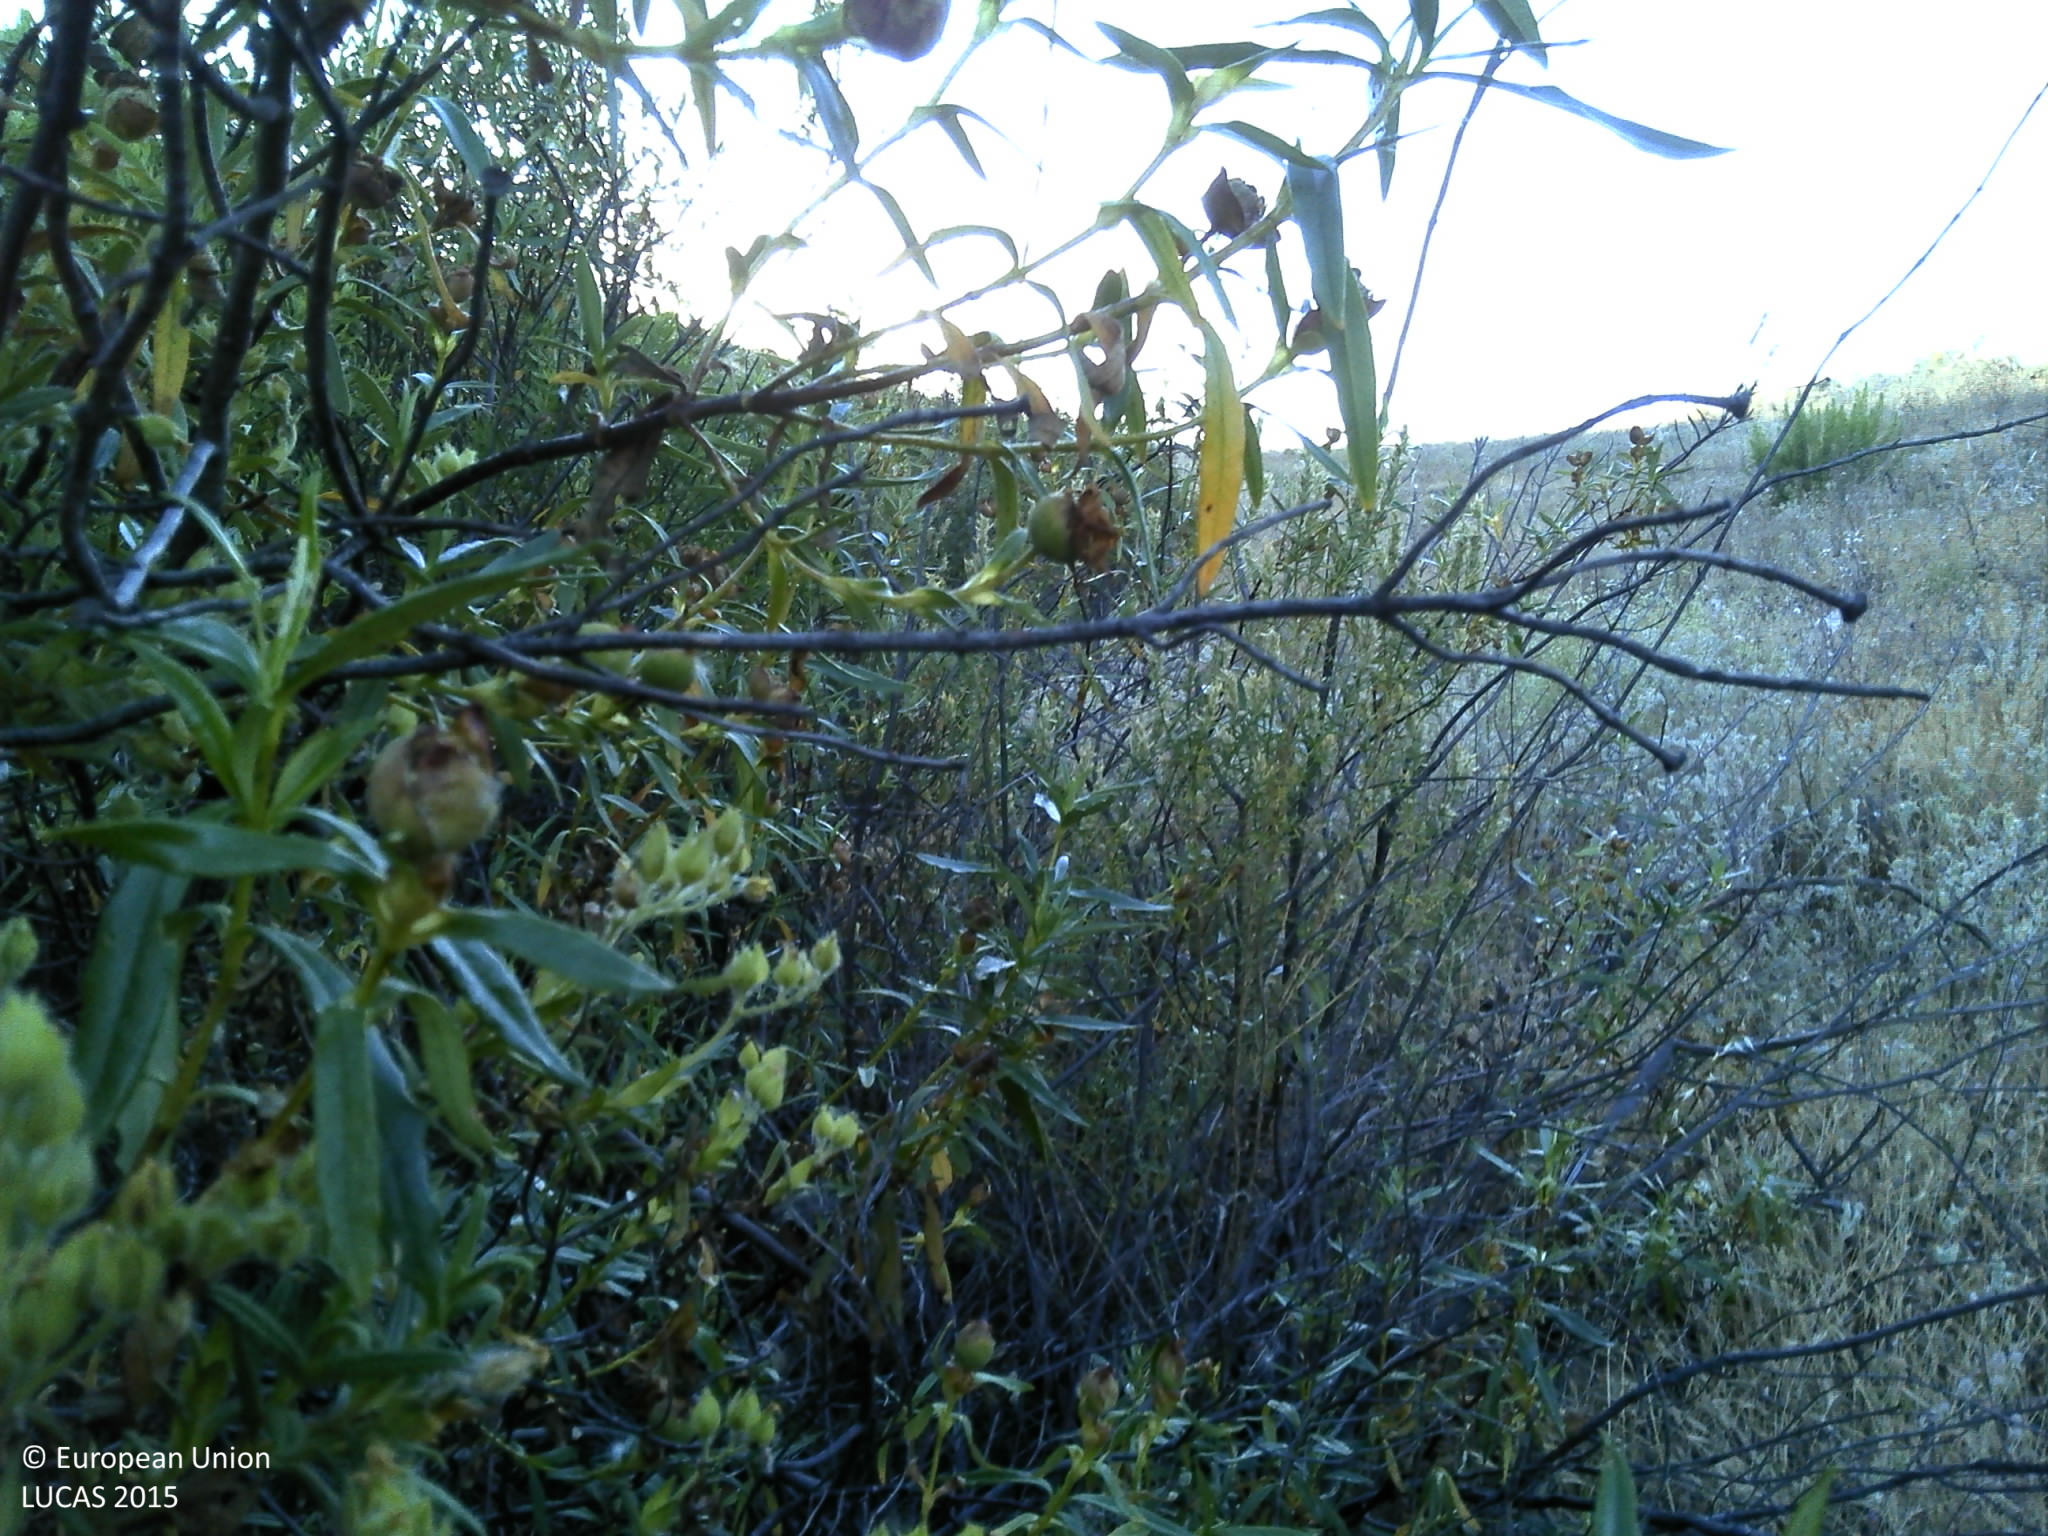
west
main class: Shrubland
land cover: Shrubland without tree cover
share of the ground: > 75 %
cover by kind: shrubs 100 %
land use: Semi-natural and natural areas not in use
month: May
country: PT
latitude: 37.4574
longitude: -7.5204
